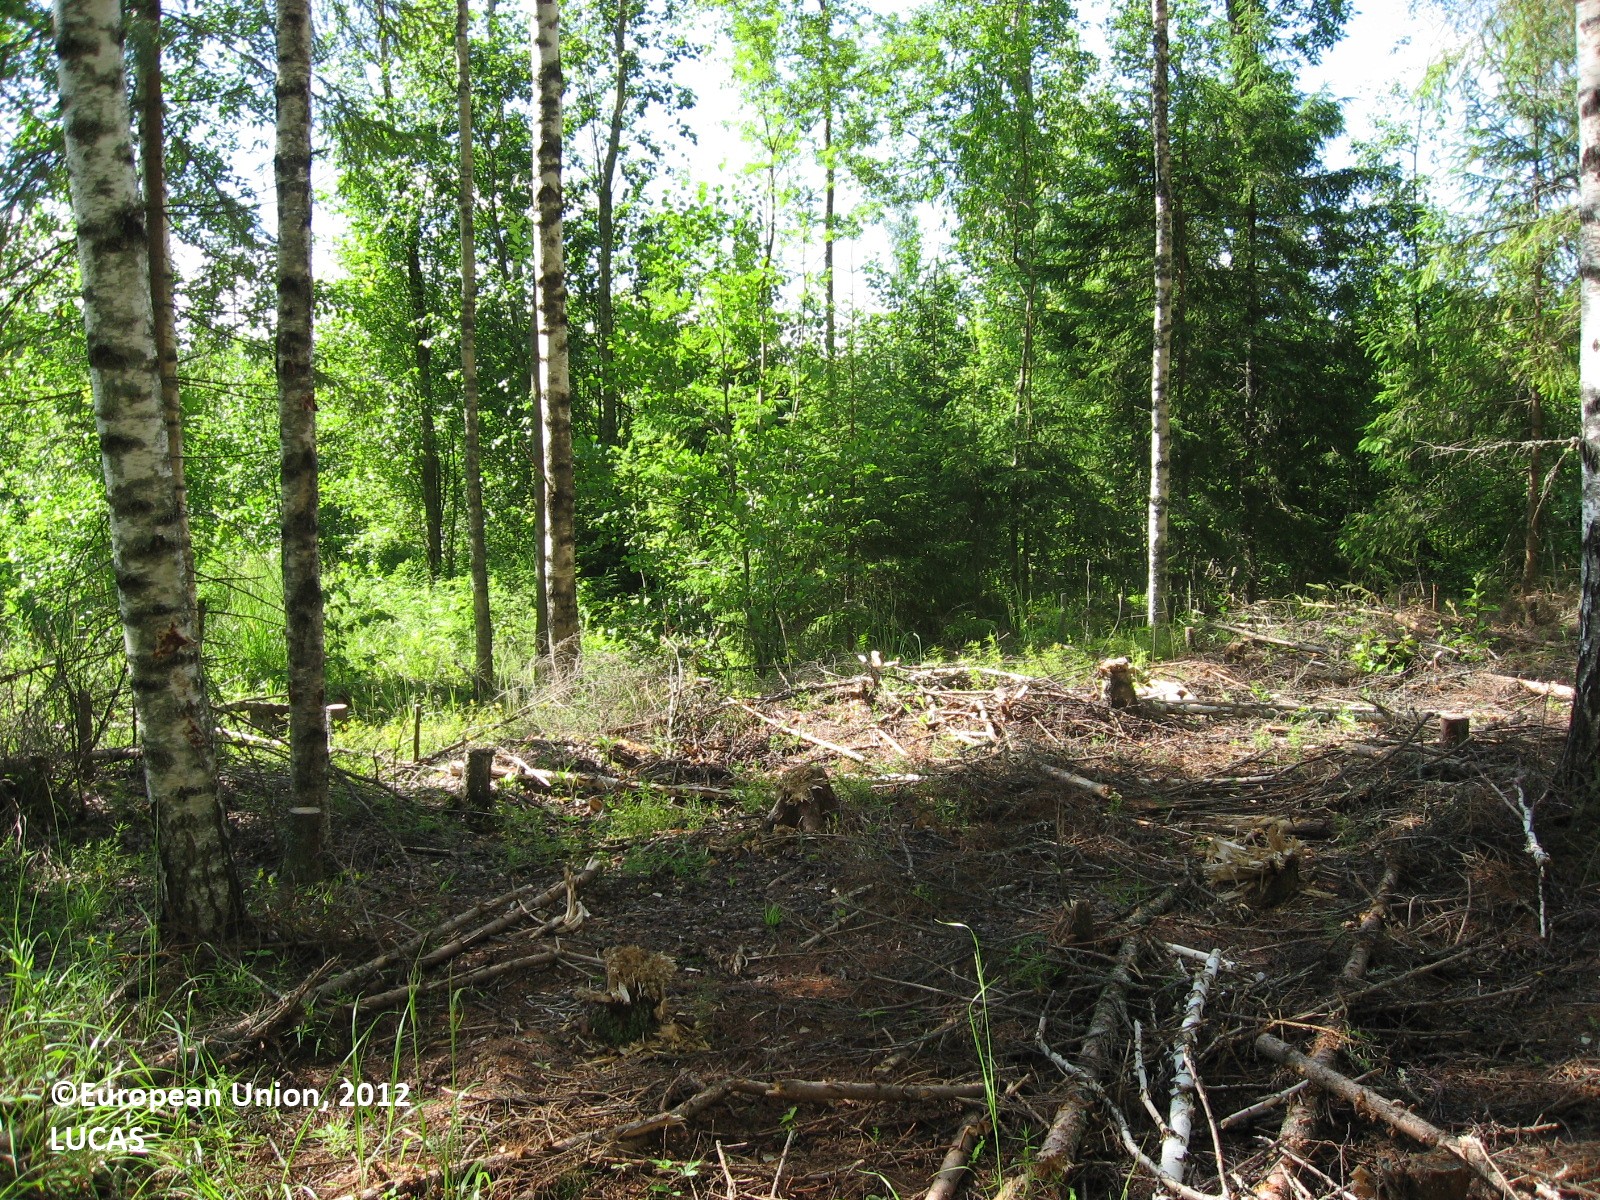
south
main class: Woodland
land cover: Other mixed woodland
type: boreal forest
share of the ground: 25 - 50 %
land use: Forestry
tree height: > 5 m
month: June
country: FI
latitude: 60.6835
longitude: 26.4293
